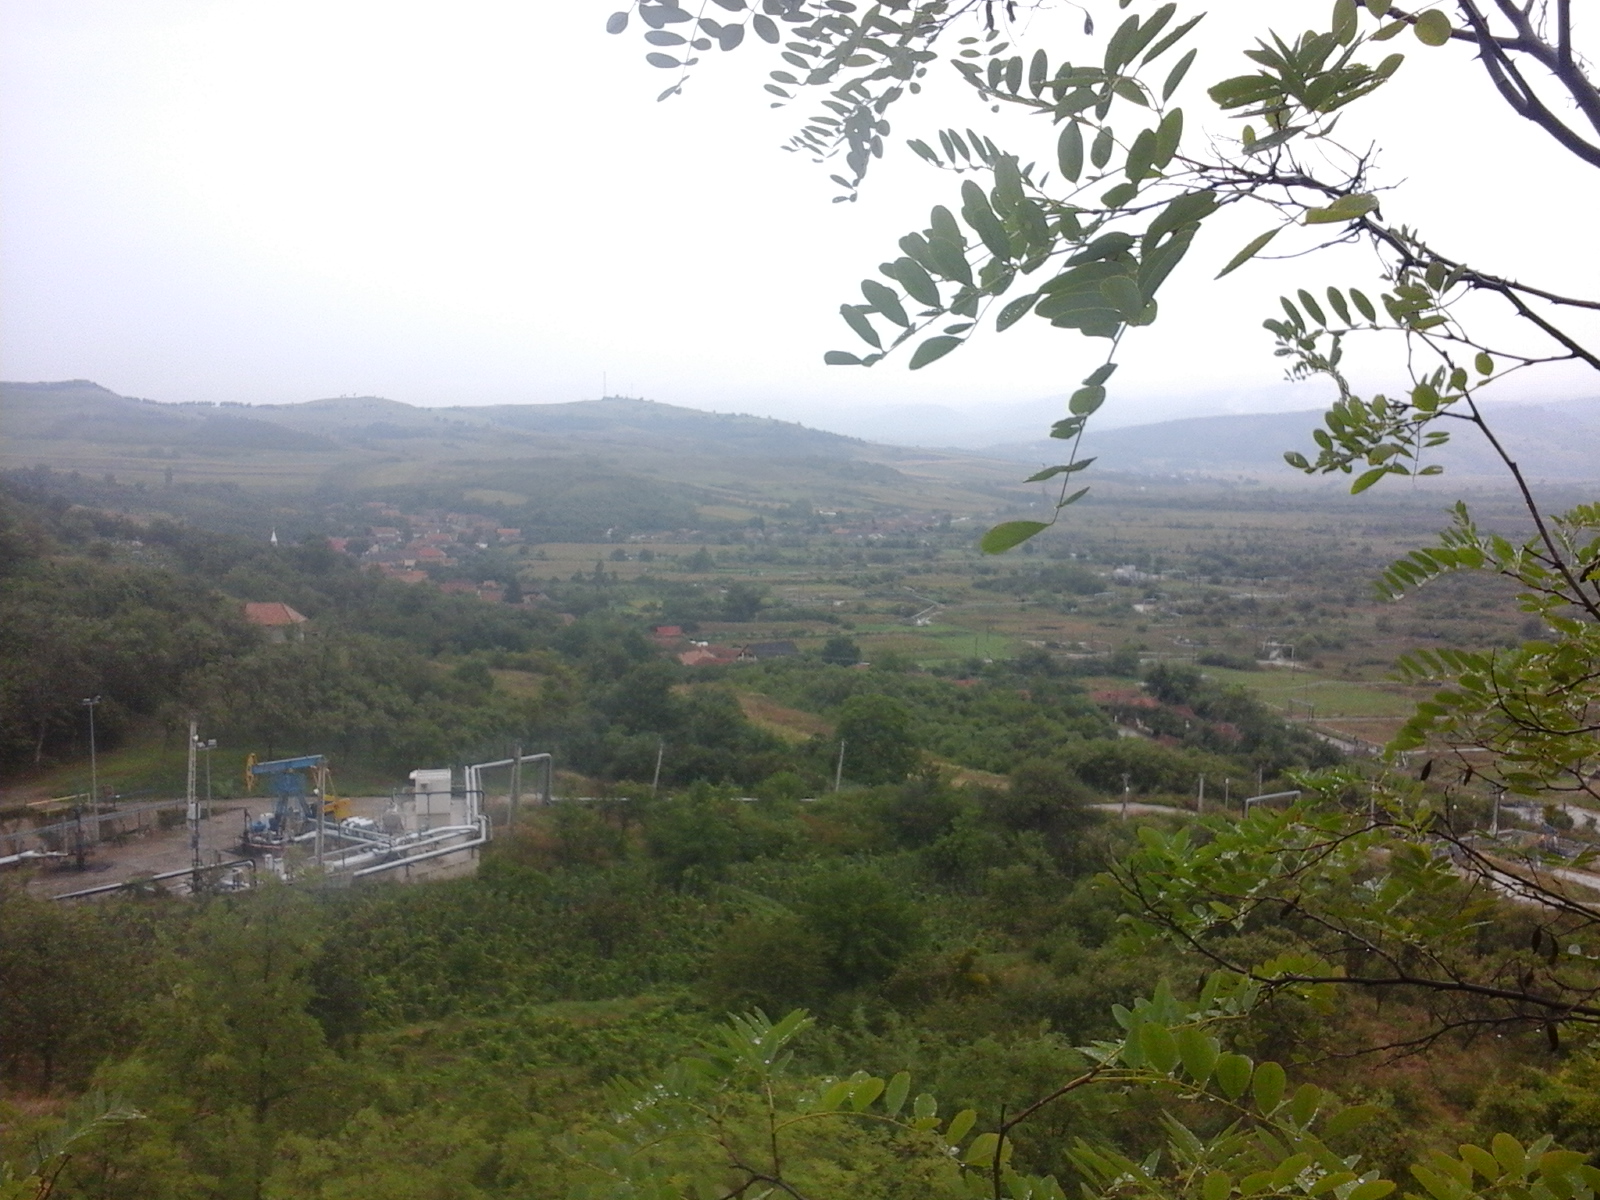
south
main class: Shrubland
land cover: Shrubland with sparse tree cover
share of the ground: > 75 %
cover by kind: shrubs 95 %, broadleaved forest trees 5 %
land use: Fallow land
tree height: < 5 m
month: September
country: RO
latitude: 47.2636
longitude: 22.5725
